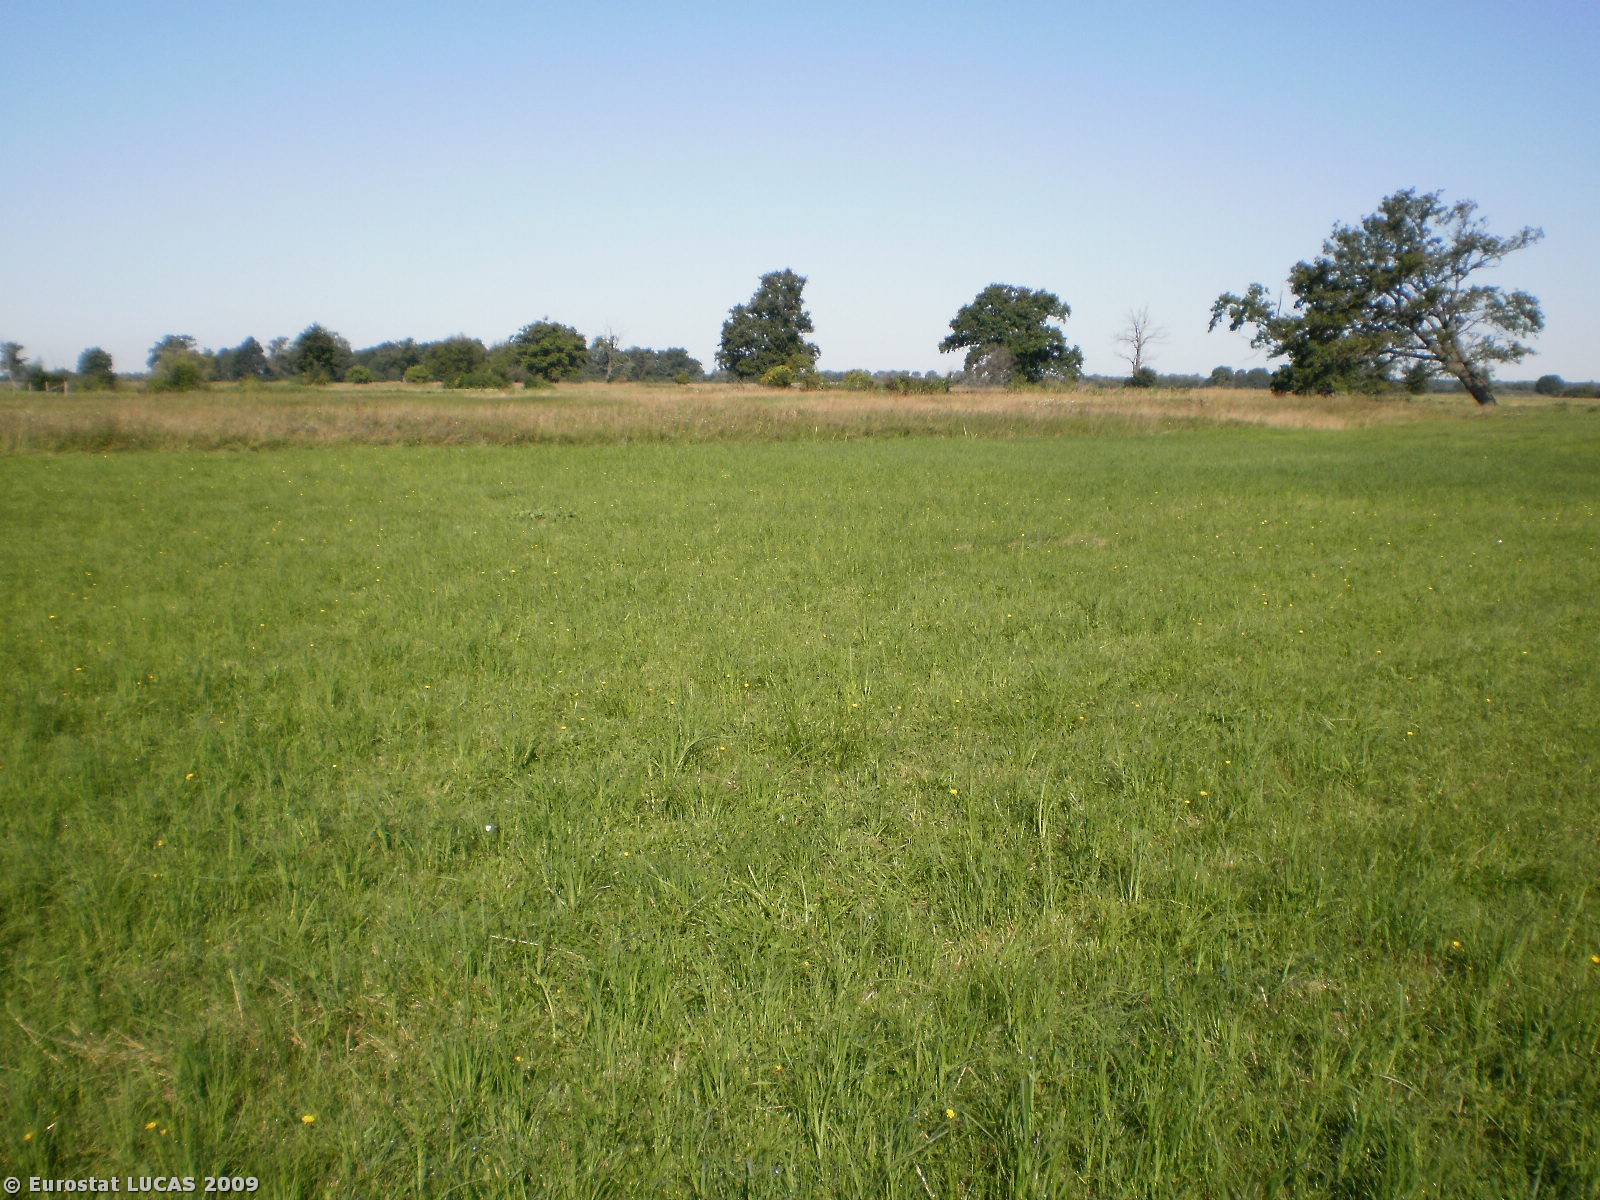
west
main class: Grassland
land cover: Grassland without tree/shrub cover
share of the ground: > 75 %
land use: Agriculture (excluding fallow land and kitchen gardens)
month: August
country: PL
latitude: 52.6137
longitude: 21.7065
